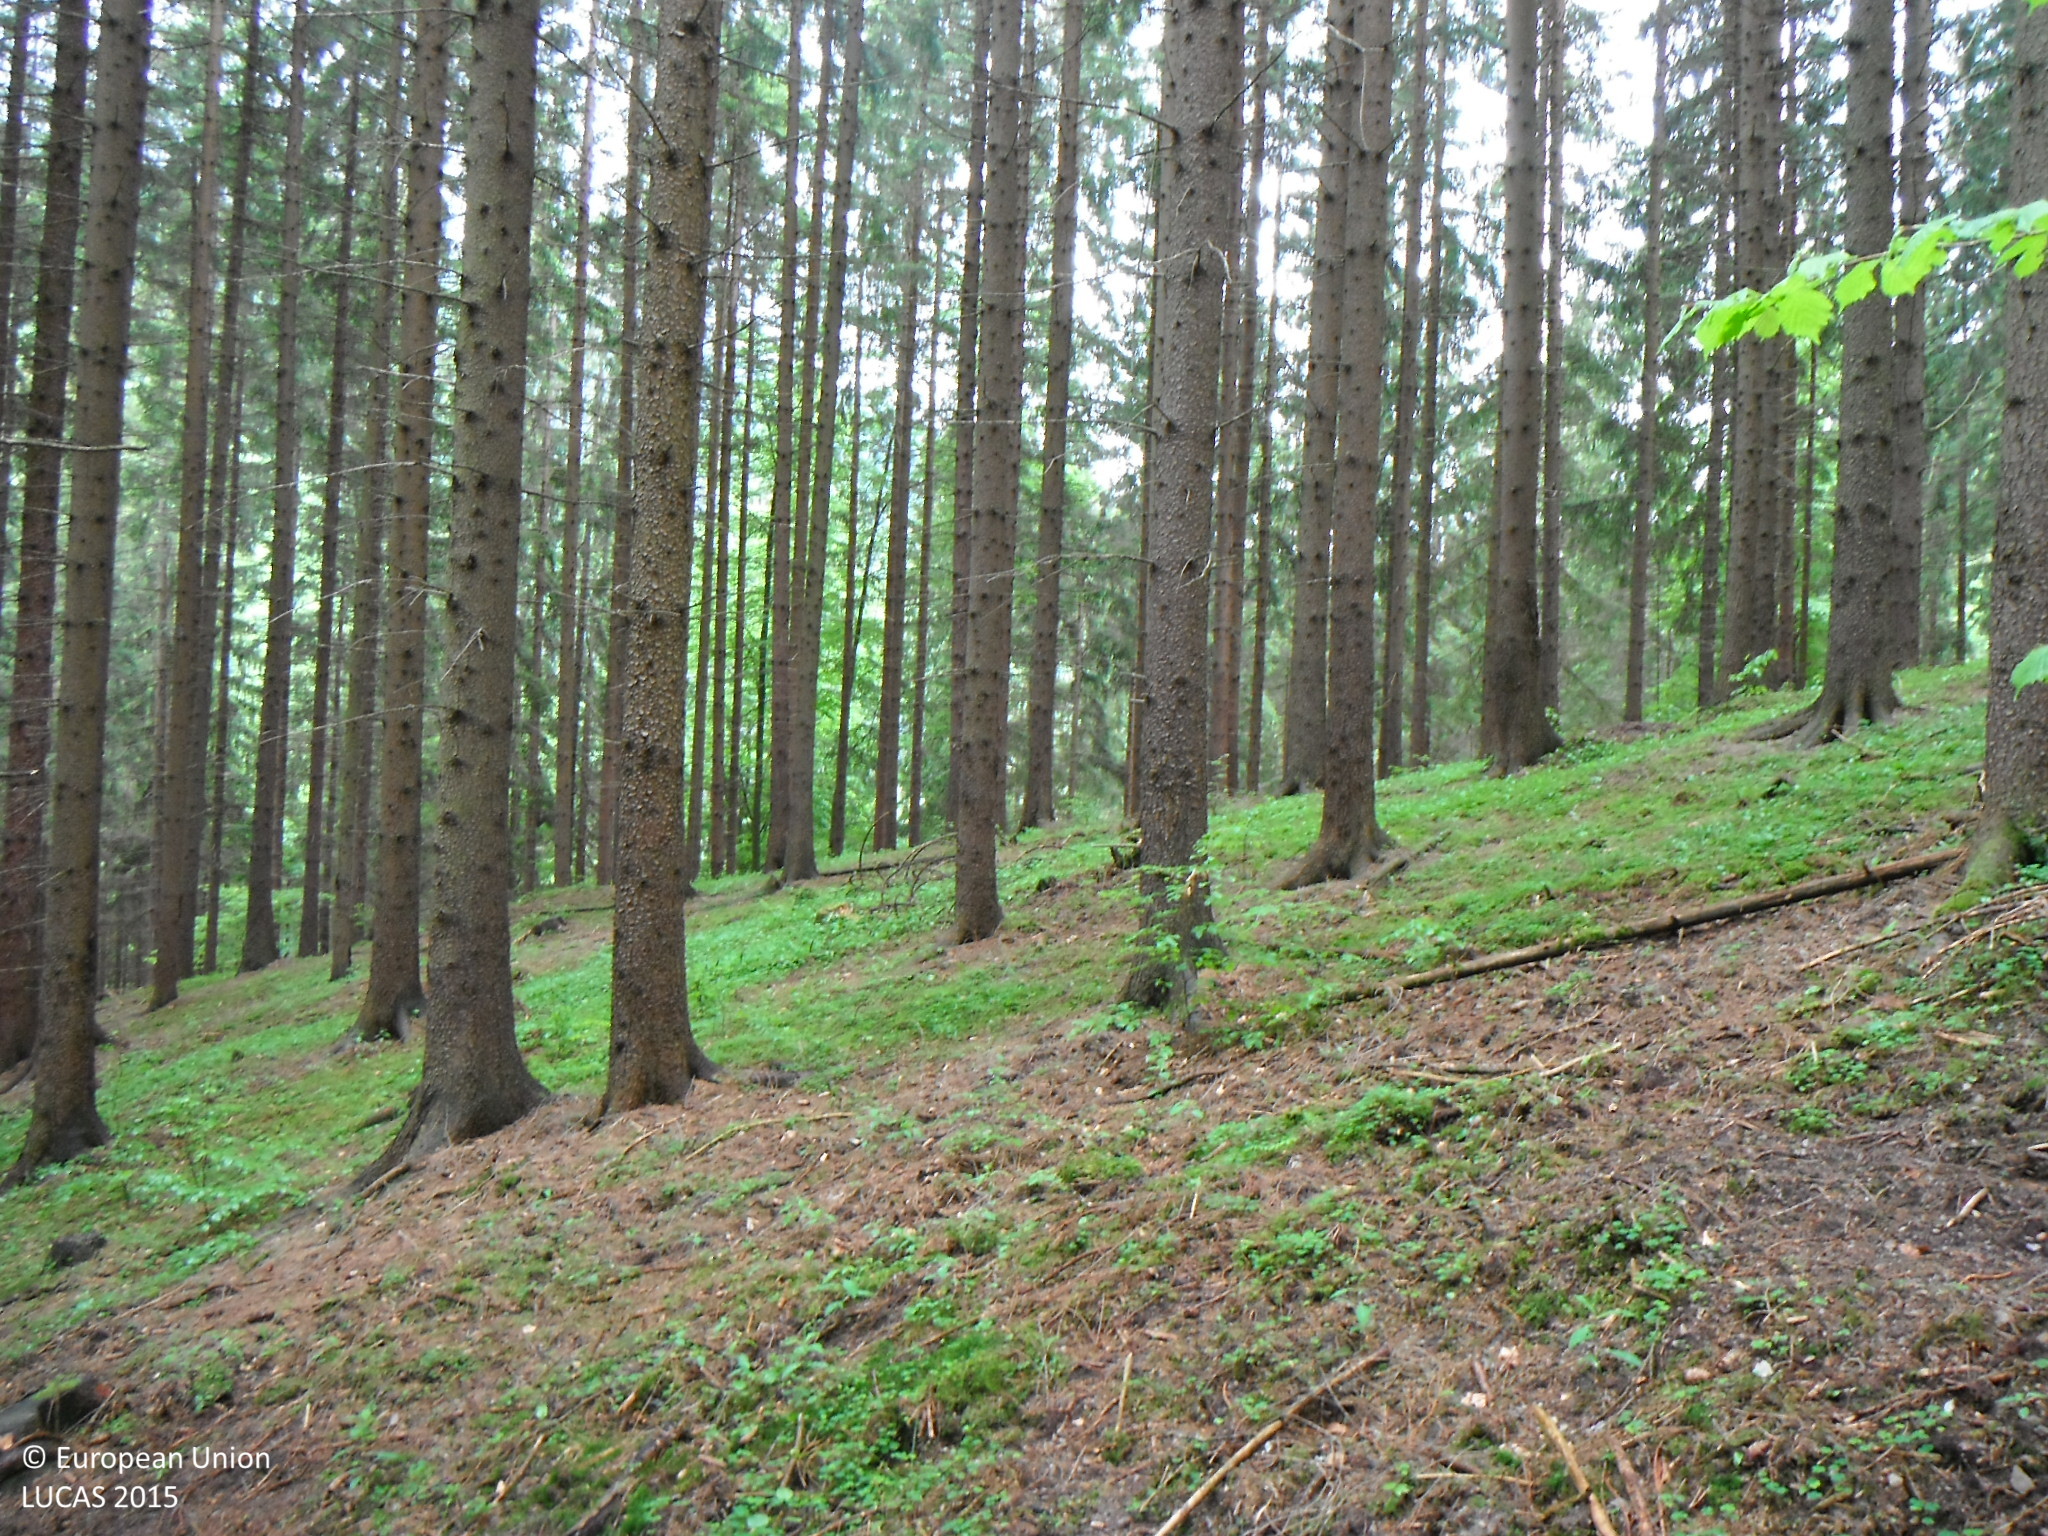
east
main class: Woodland
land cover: Spruce dominated coniferous woodland
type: alpine coniferous forest
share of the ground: > 75 %
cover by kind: coniferous forest trees 100 %
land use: Forestry
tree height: > 5 m
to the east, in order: Spruce dominated coniferous woodland; Spruce dominated mixed woodland; Spontaneously vegetated surfaces; Spruce dominated coniferous woodland; Grassland without tree/shrub cover
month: May
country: SK
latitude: 48.9929
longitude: 19.0283
